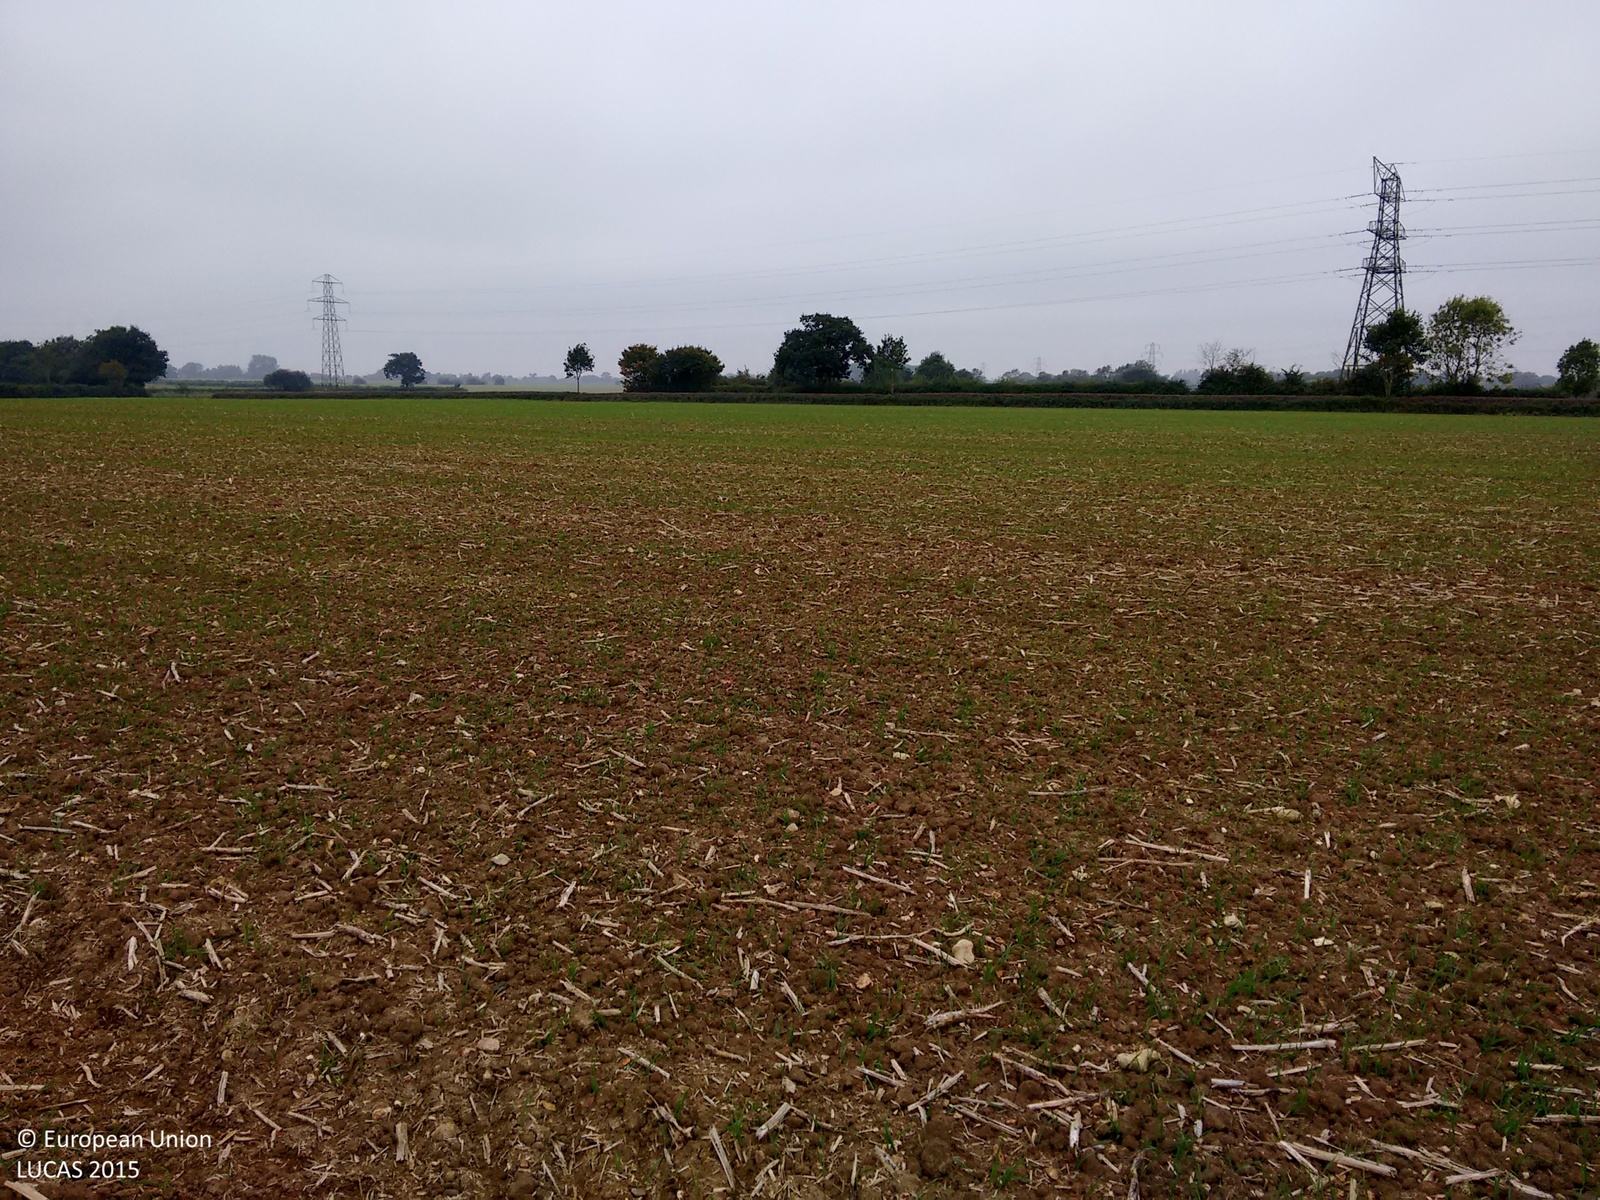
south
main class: Cropland
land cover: Common wheat
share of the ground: < 10 %
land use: Agriculture (excluding fallow land and kitchen gardens)
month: October
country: GB
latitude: 52.3956
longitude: 1.4717
